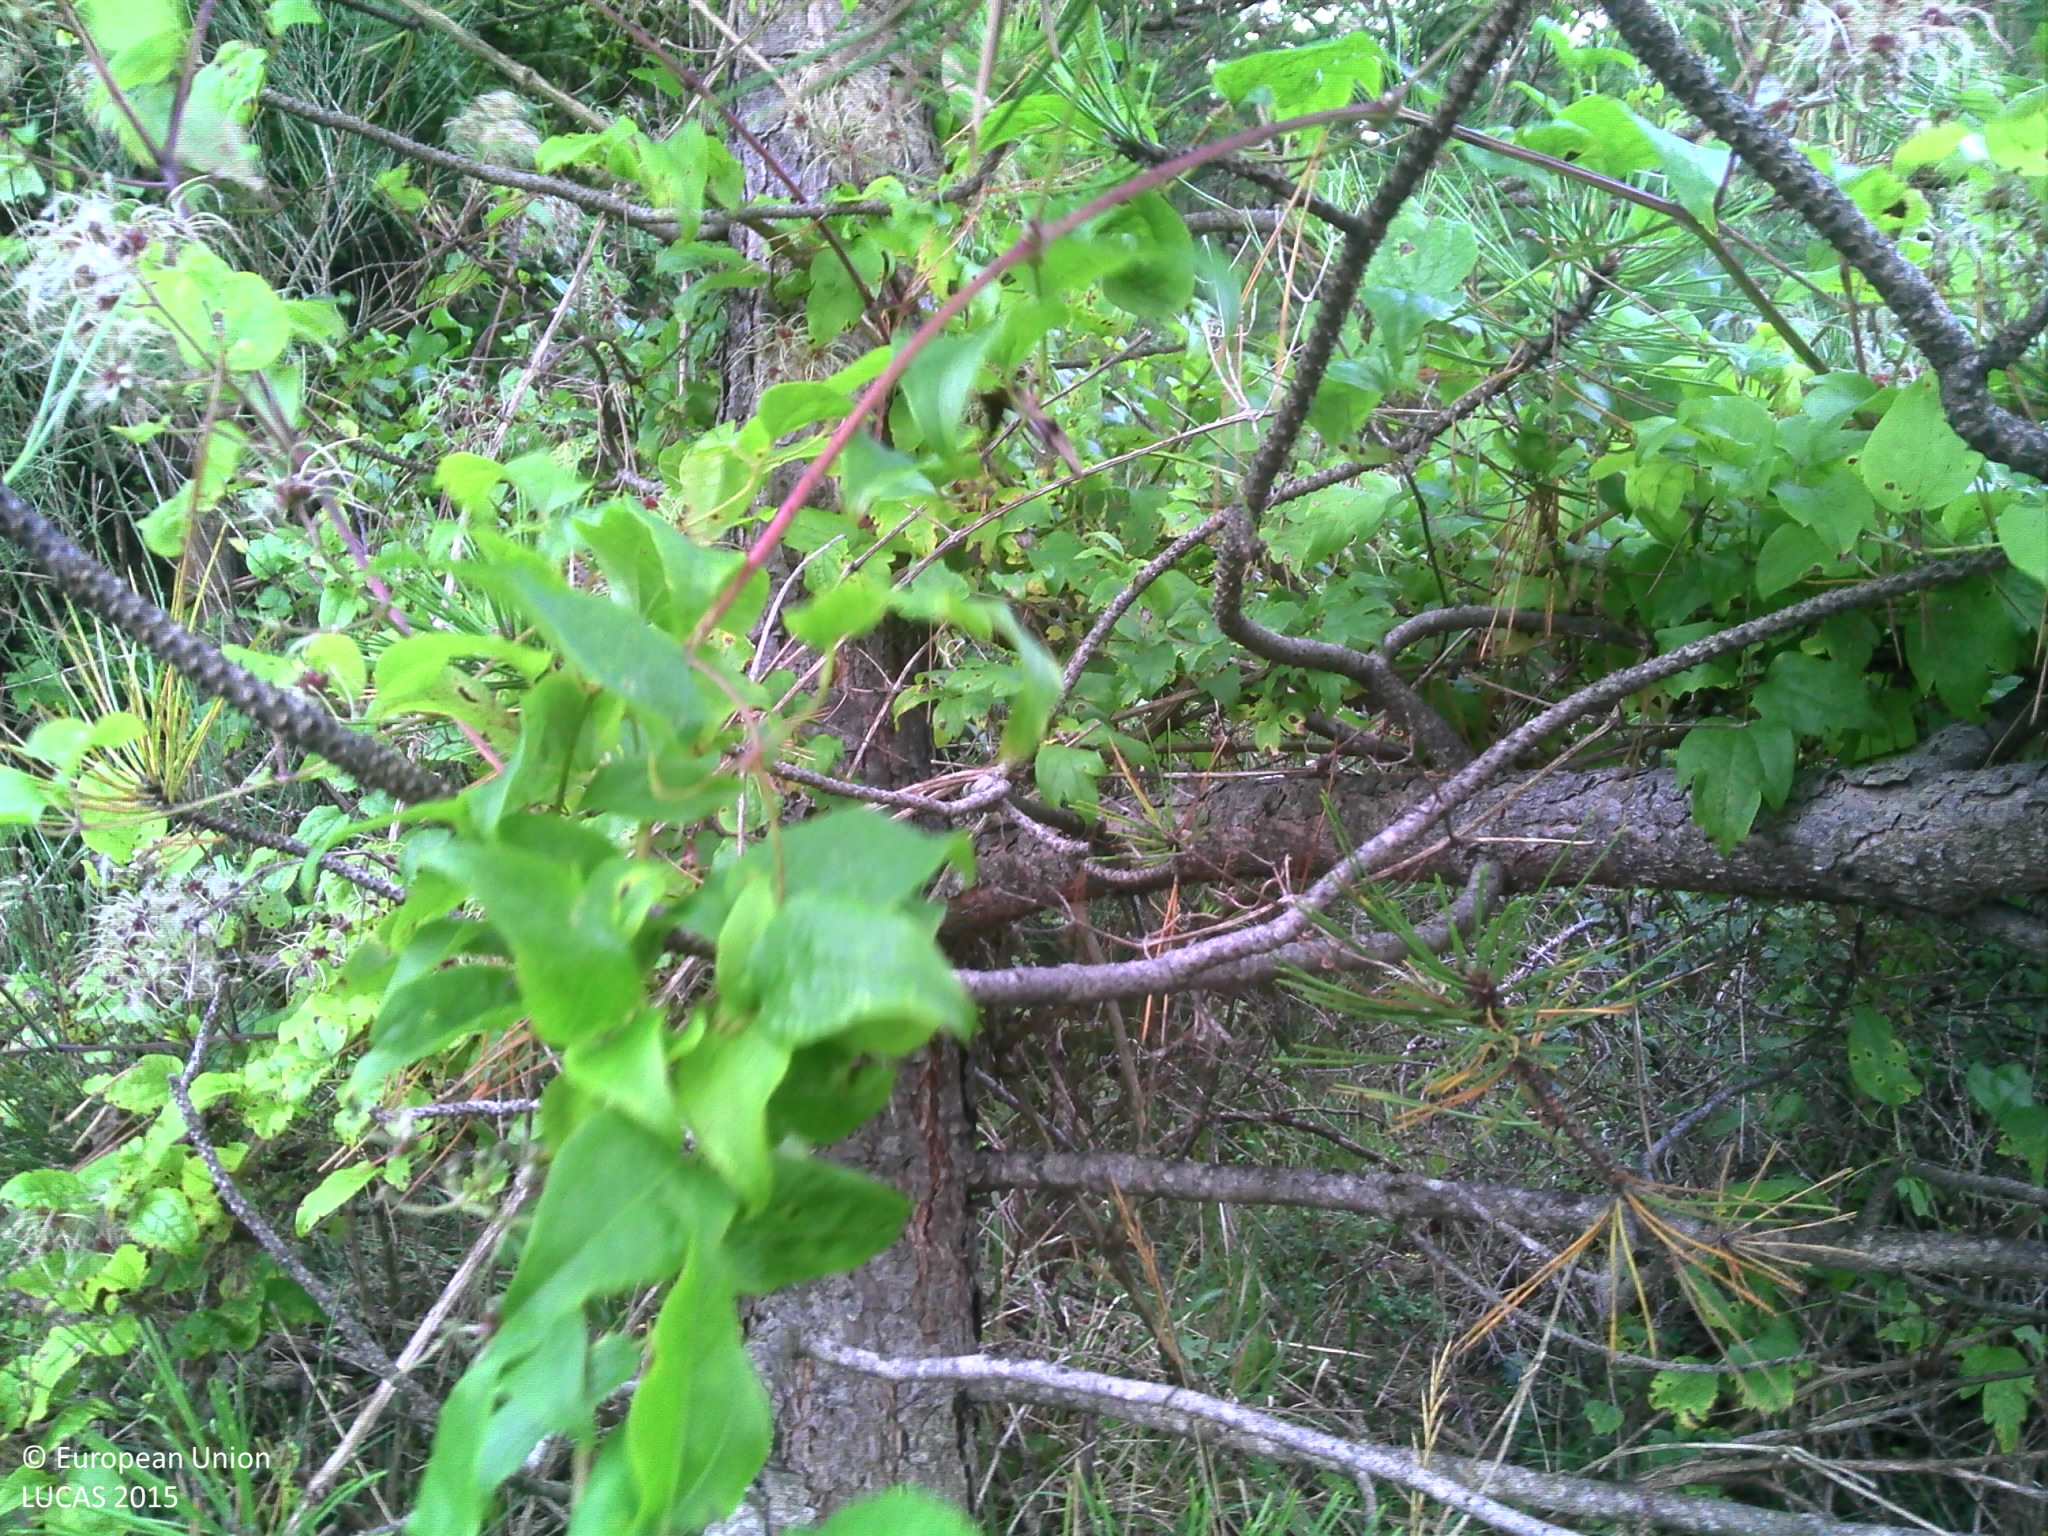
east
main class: Woodland
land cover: Pine dominated coniferous woodland
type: alpine coniferous forest
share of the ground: > 75 %
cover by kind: coniferous forest trees 75 %, shrubs 10 %, broadleaved forest trees 5 %, herbaceous plants 5 %, consolidated bare surface 5 %
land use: Forestry
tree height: > 5 m
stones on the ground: < 10 %
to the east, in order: Pine dominated coniferous woodland; Pine dominated mixed woodland; Pine dominated coniferous woodland; Pine dominated mixed woodland; Grass margins; Paved roads, cycling and walking lanes; Grass margins; Ditches and canals; Pine dominated mixed woodland
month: September
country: FR
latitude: 44.4367
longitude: 5.5723
